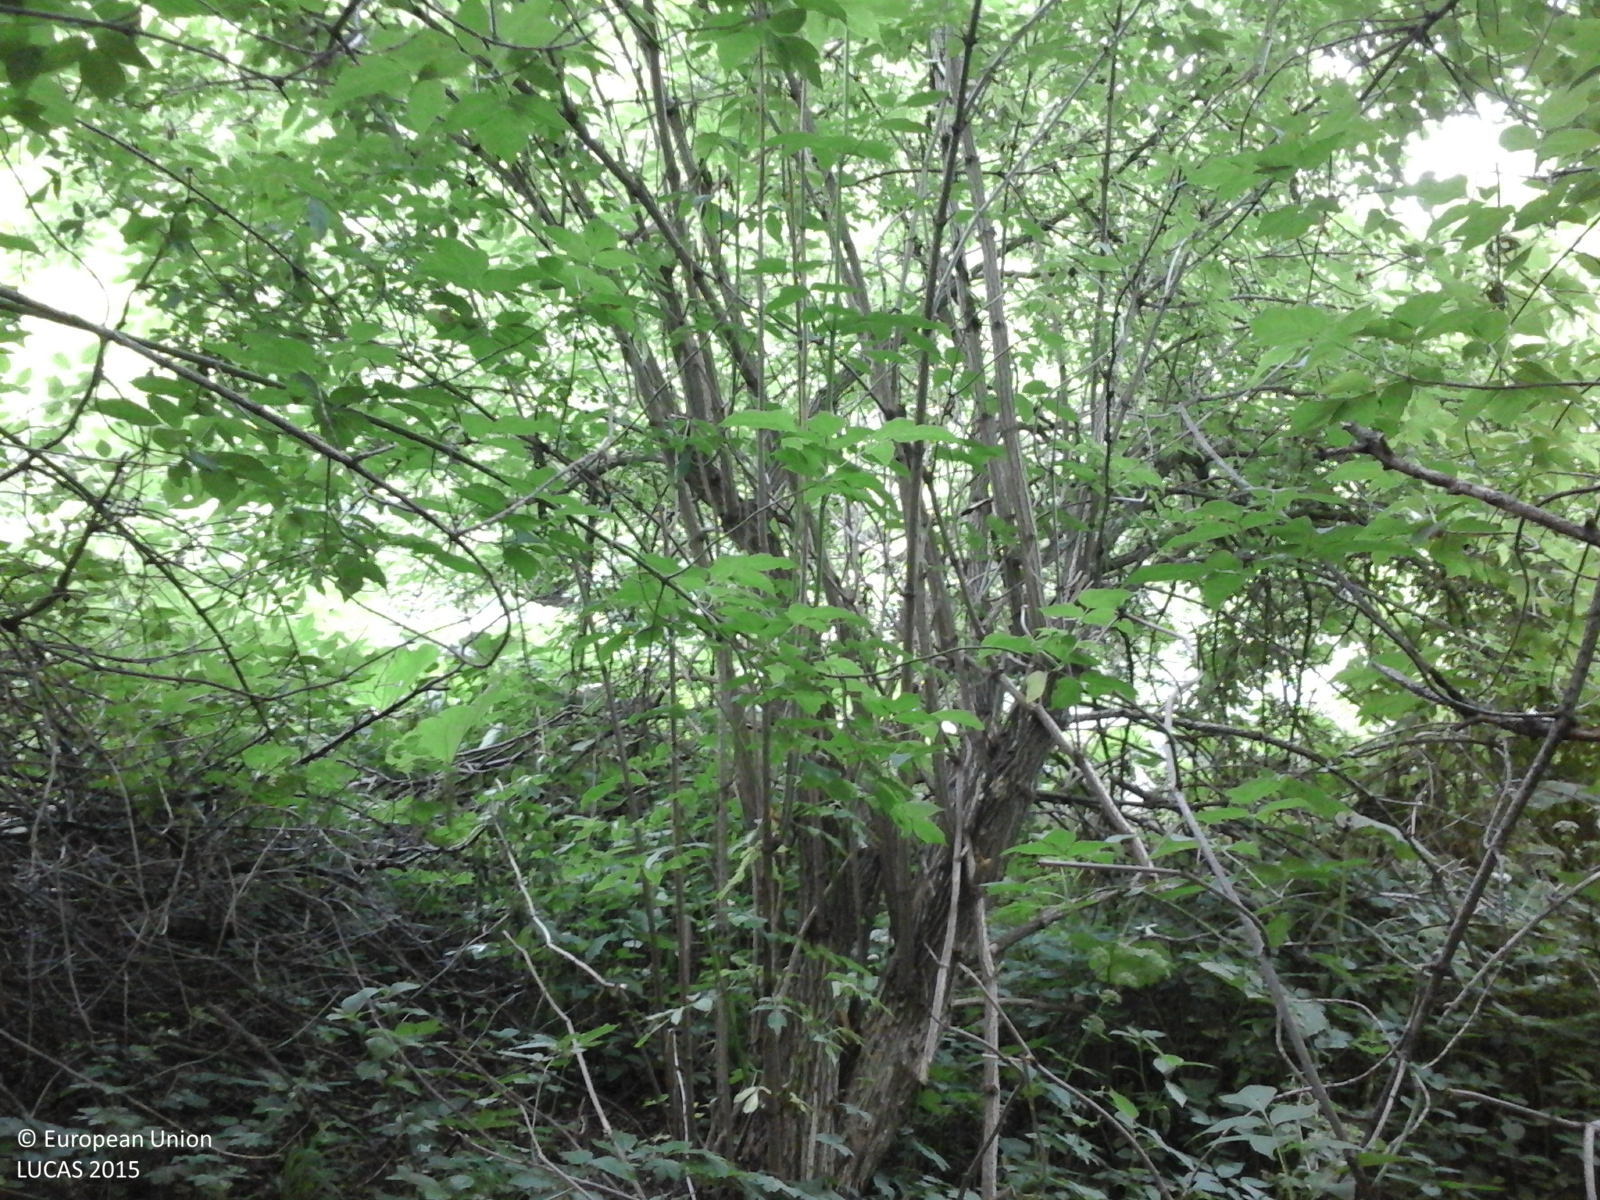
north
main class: Woodland
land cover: Broadleaved woodland
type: non-riverine alder, birch or aspen forest
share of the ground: > 75 %
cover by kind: broadleaved forest trees 100 %
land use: Forestry
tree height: > 5 m
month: June
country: RO
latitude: 47.4806
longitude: 26.3952
